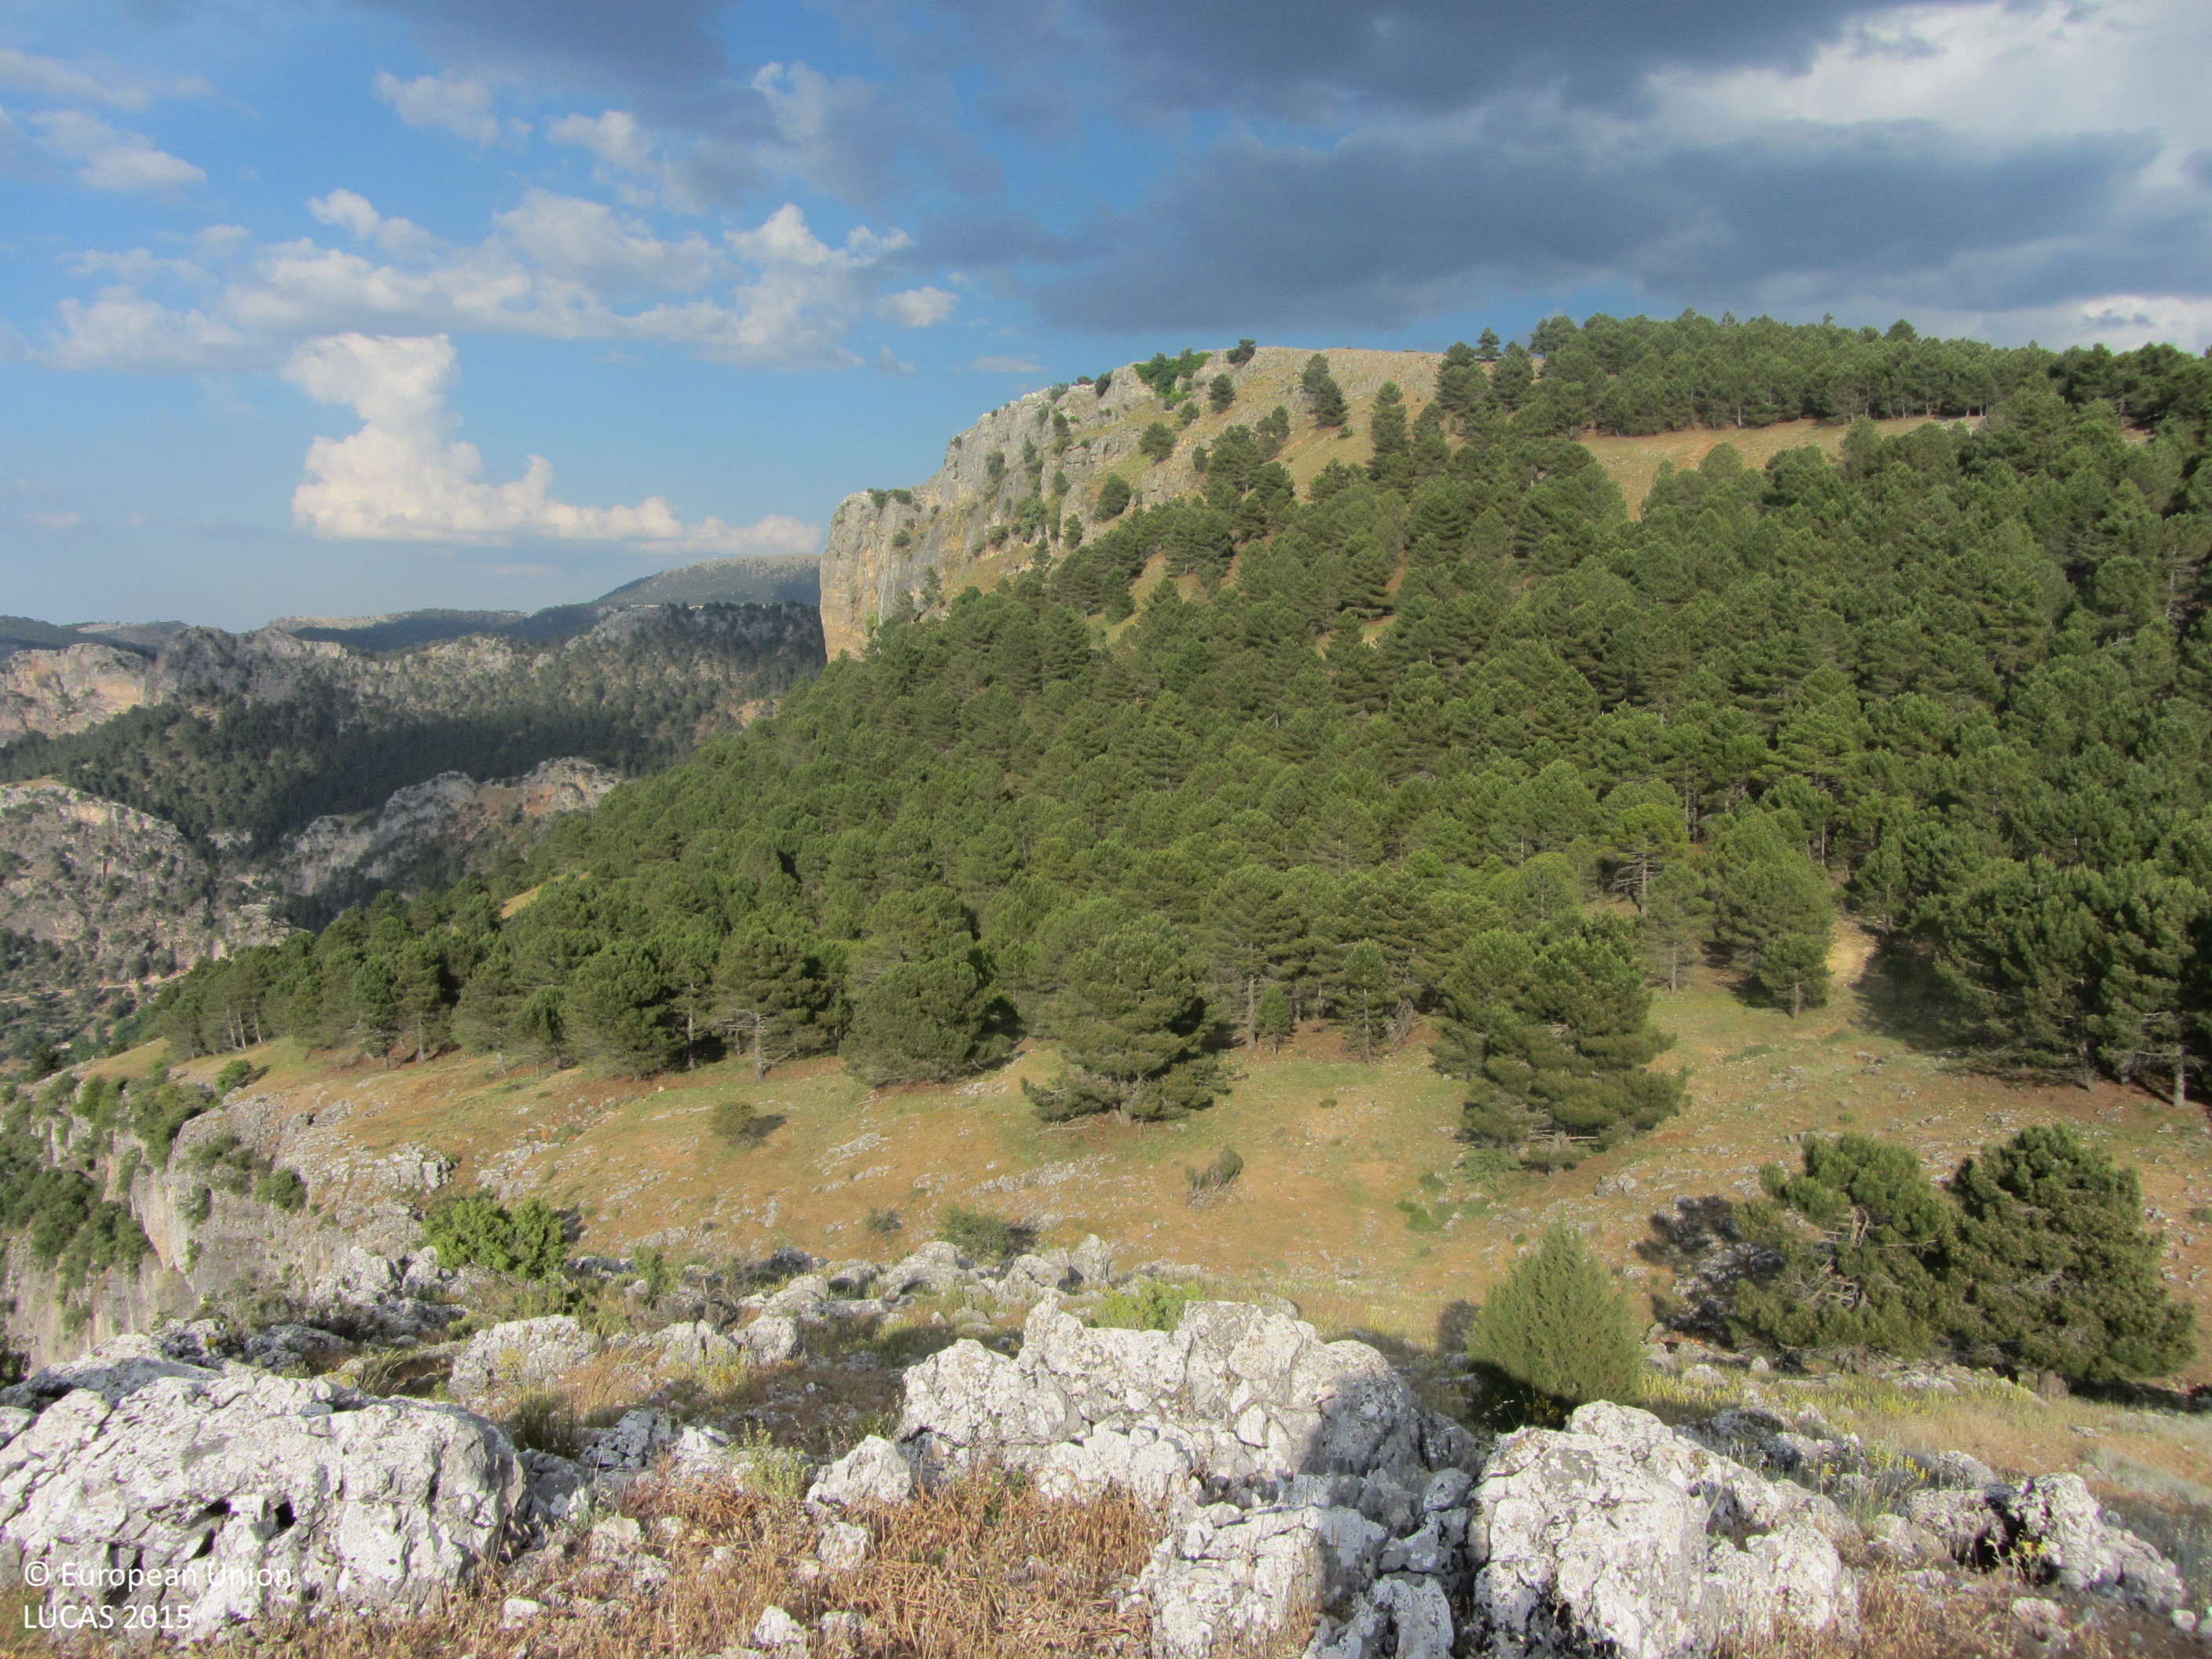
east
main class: Woodland
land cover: Pine dominated coniferous woodland
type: coniferous forest of the mediterranean region
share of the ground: 50 - 75 %
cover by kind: coniferous forest trees 70 %, herbaceous plants 30 %
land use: Semi-natural and natural areas not in use
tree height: > 5 m
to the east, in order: Pine dominated coniferous woodland
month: May
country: ES
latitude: 38.1269
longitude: -2.9224
